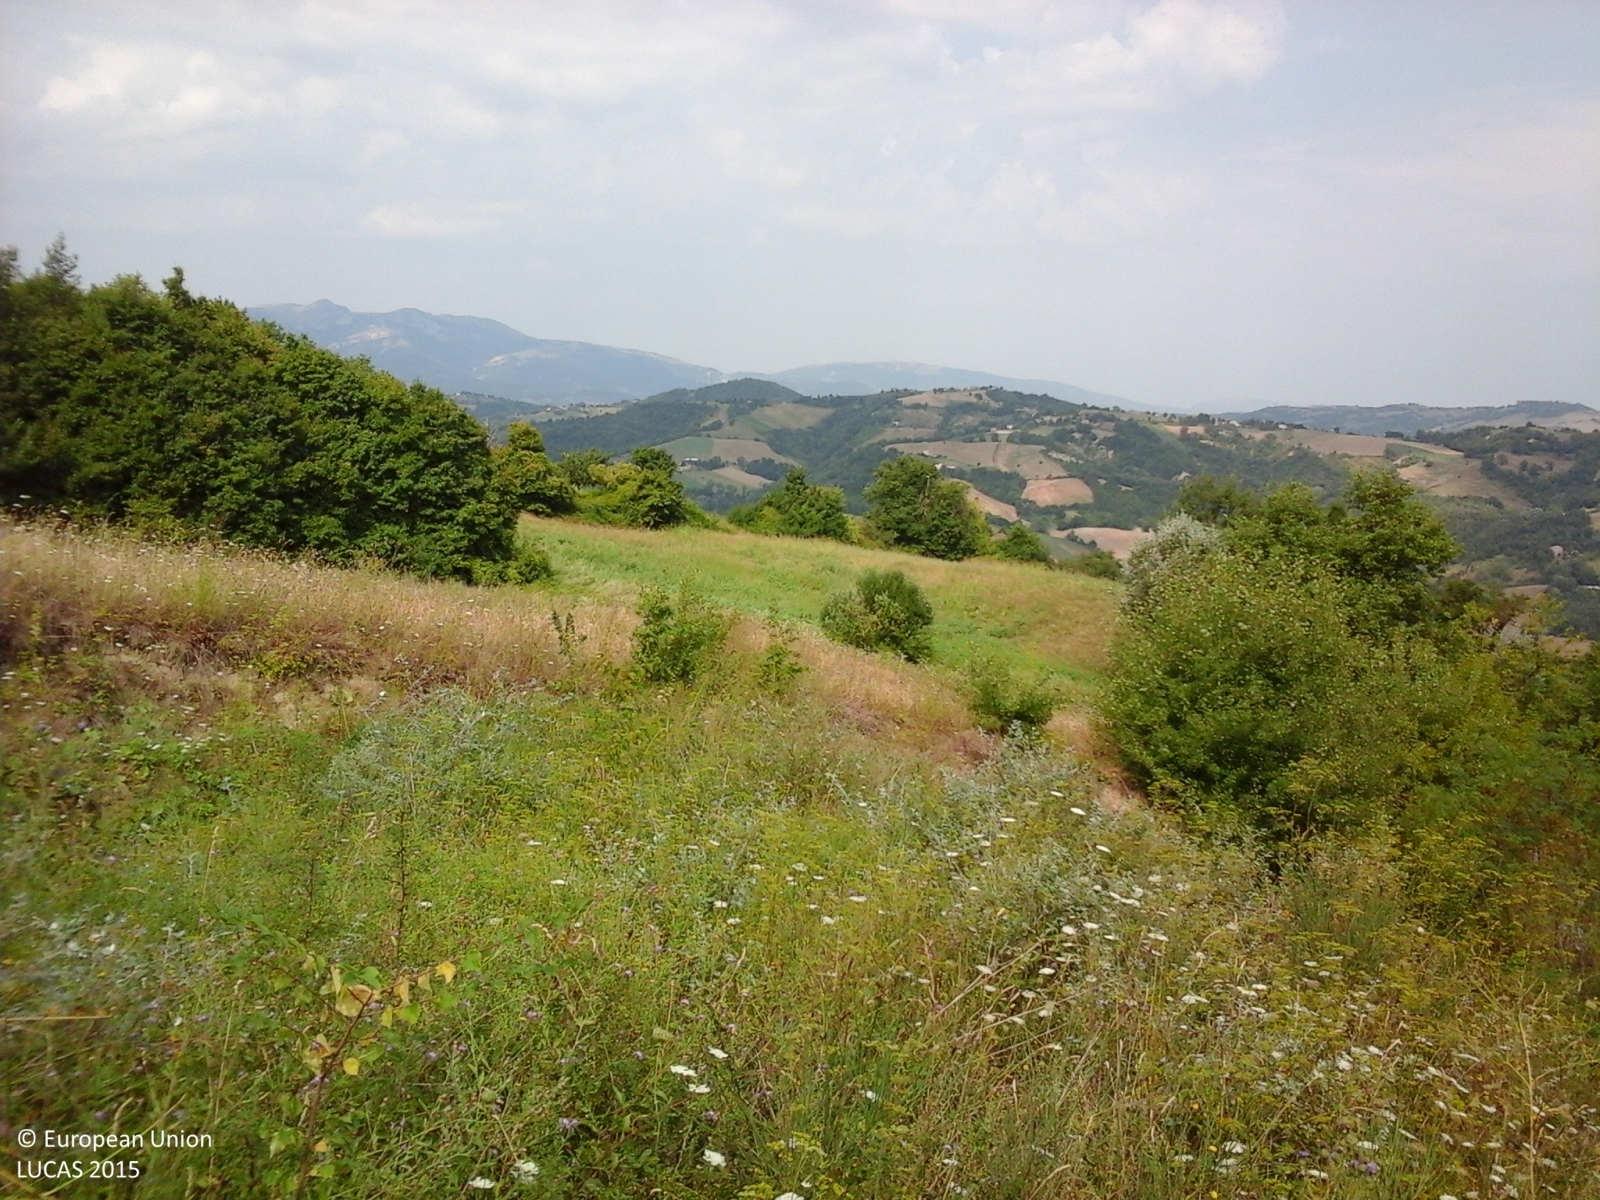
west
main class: Shrubland
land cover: Shrubland without tree cover
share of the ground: > 75 %
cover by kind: shrubs 100 %
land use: Semi-natural and natural areas not in use
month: August
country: IT
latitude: 43.0114
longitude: 13.4381
